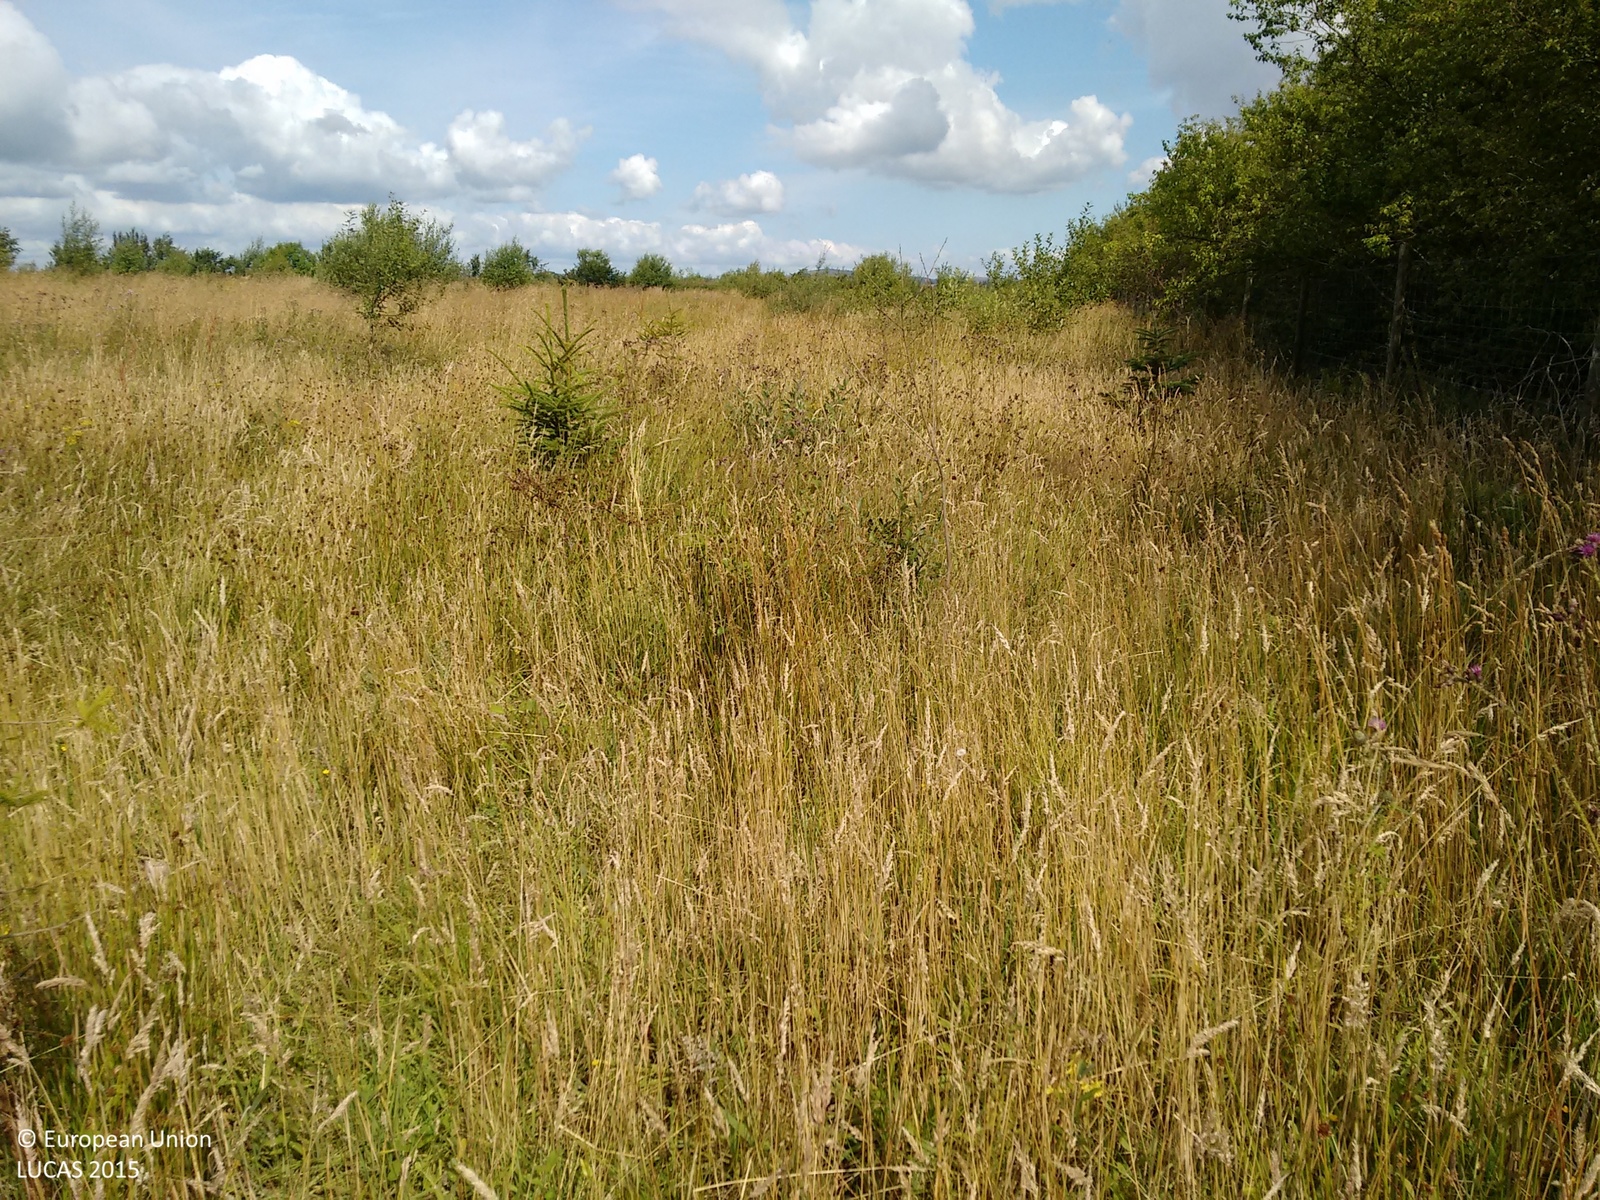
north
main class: Grassland
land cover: Grassland with sparse tree/shrub cover
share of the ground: > 75 %
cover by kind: herbaceous plants 85 %, shrubs 10 %, broadleaved forest trees 5 %
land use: Semi-natural and natural areas not in use
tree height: < 5 m
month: August
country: GB
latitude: 55.0712
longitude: -2.9591
